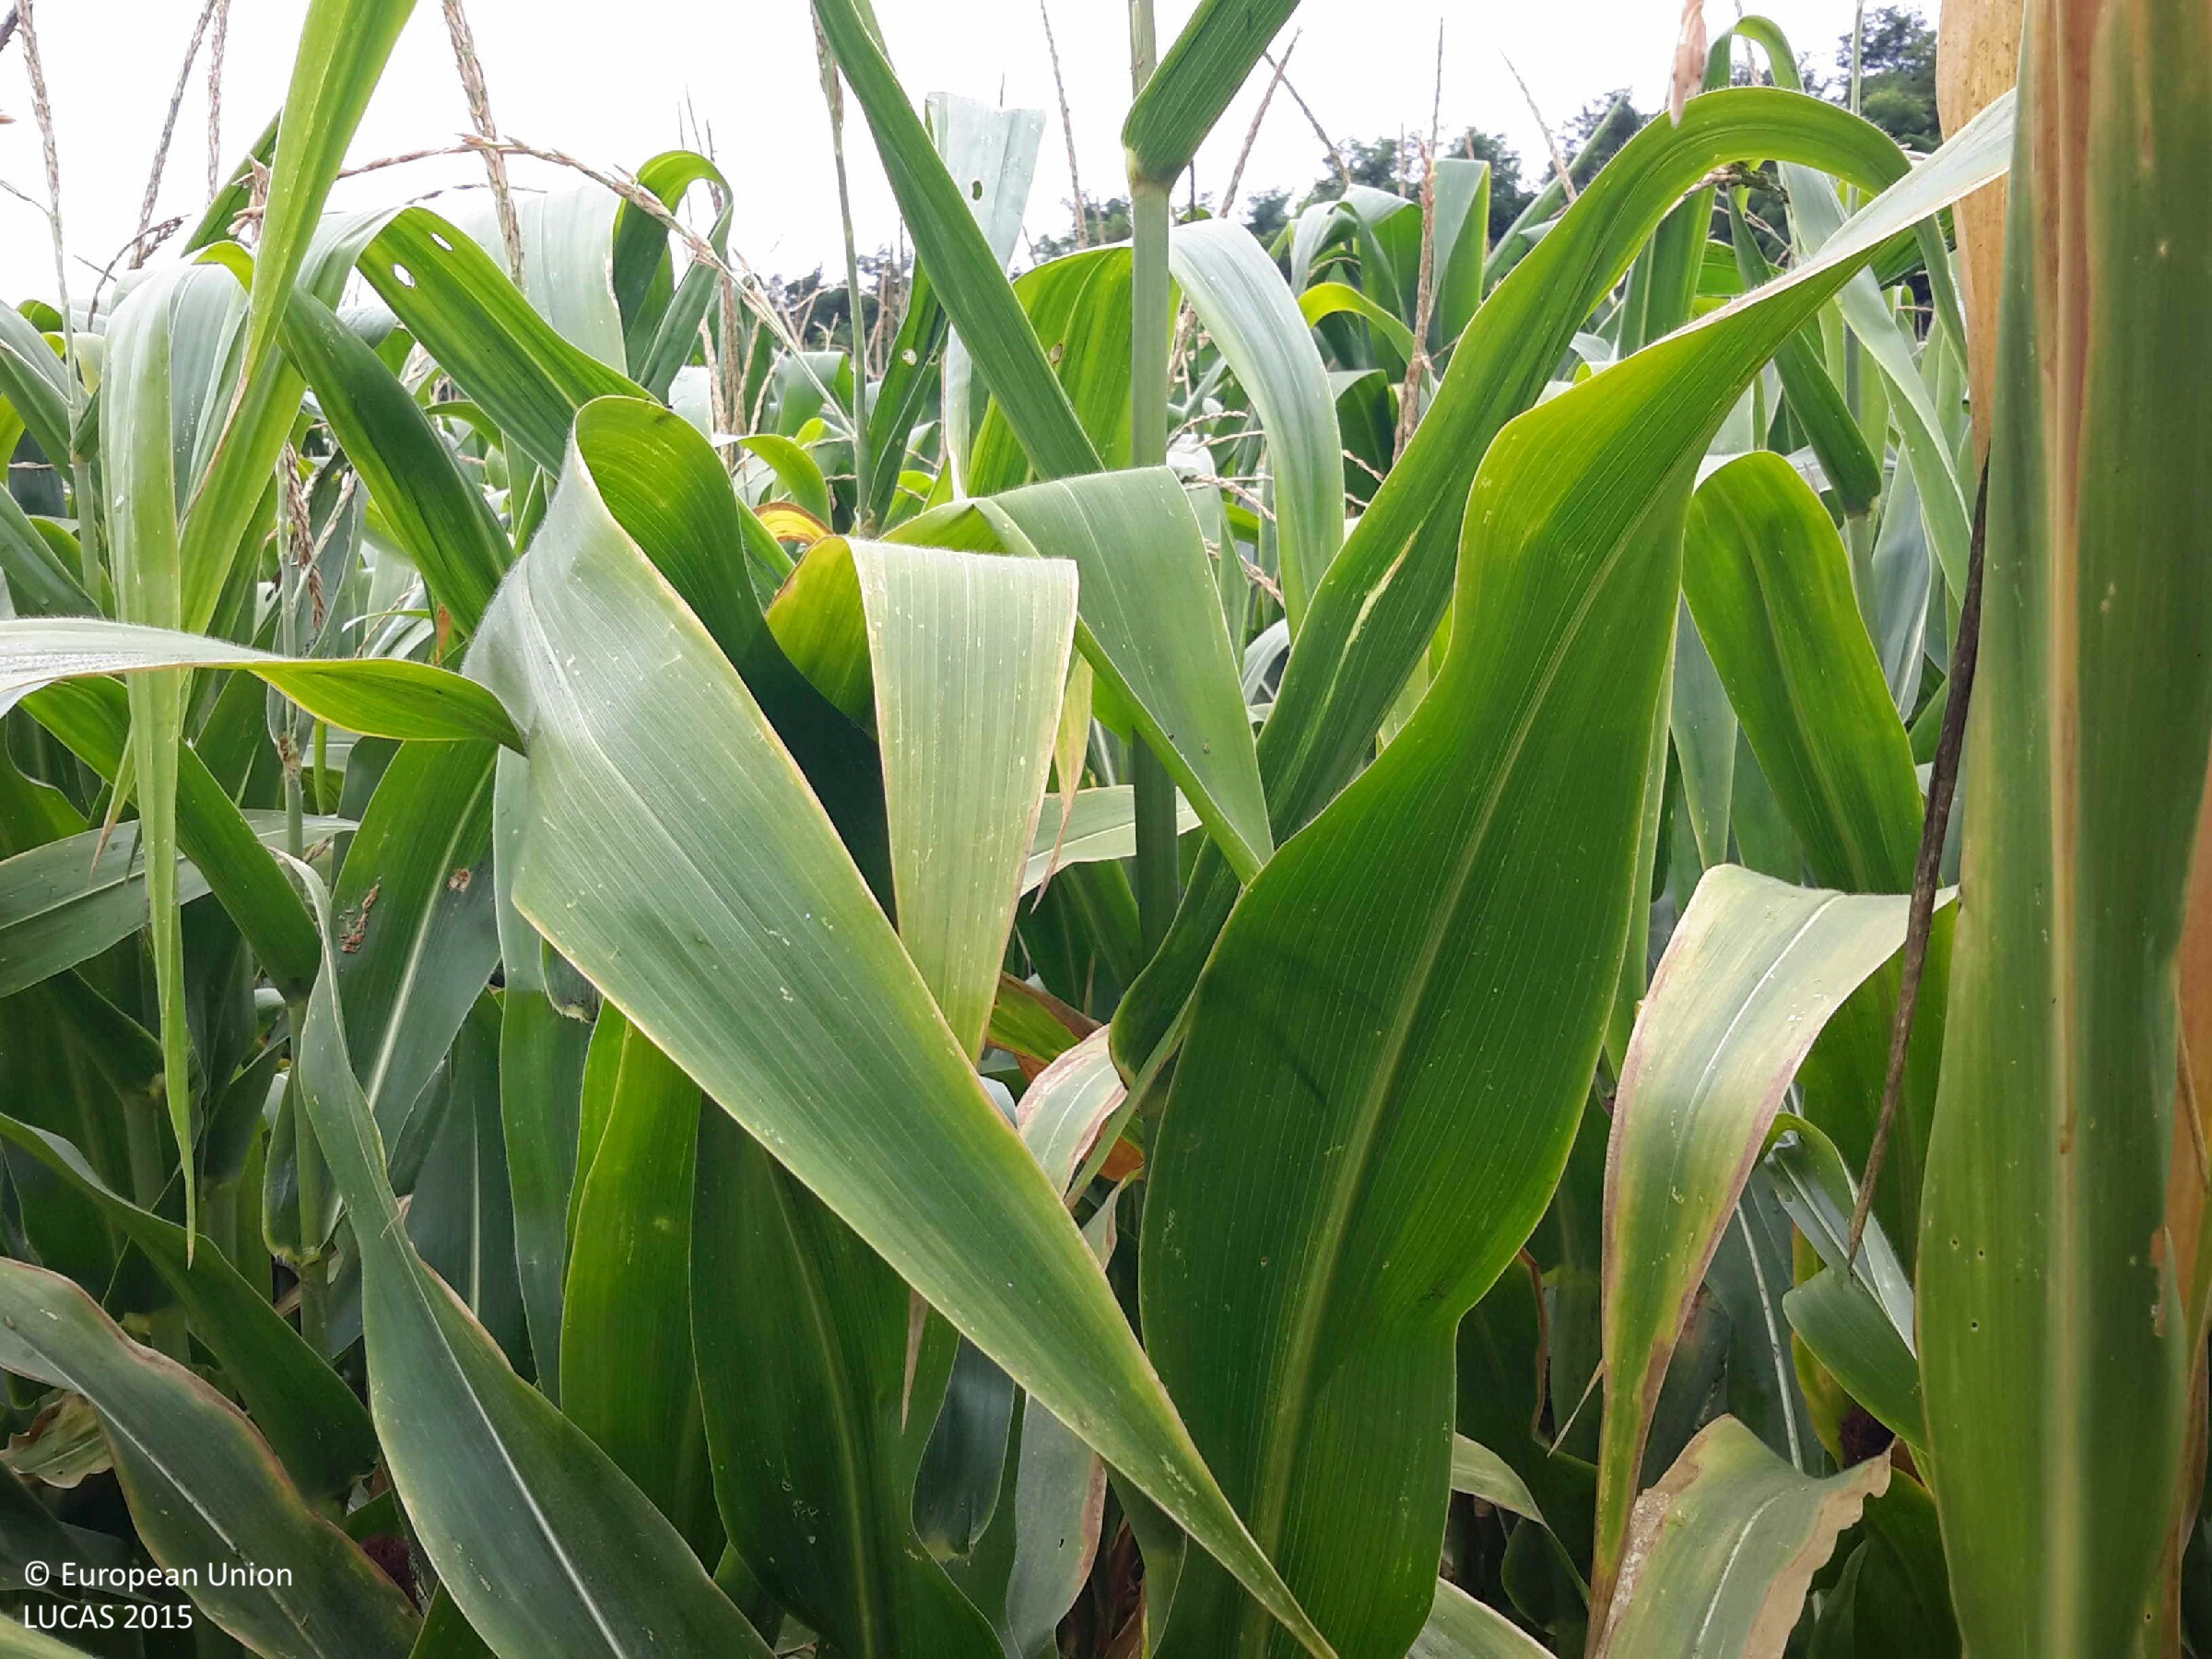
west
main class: Cropland
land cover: Maize
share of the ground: > 75 %
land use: Agriculture (excluding fallow land and kitchen gardens)
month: July
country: HU
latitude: 47.6029
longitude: 17.5504
